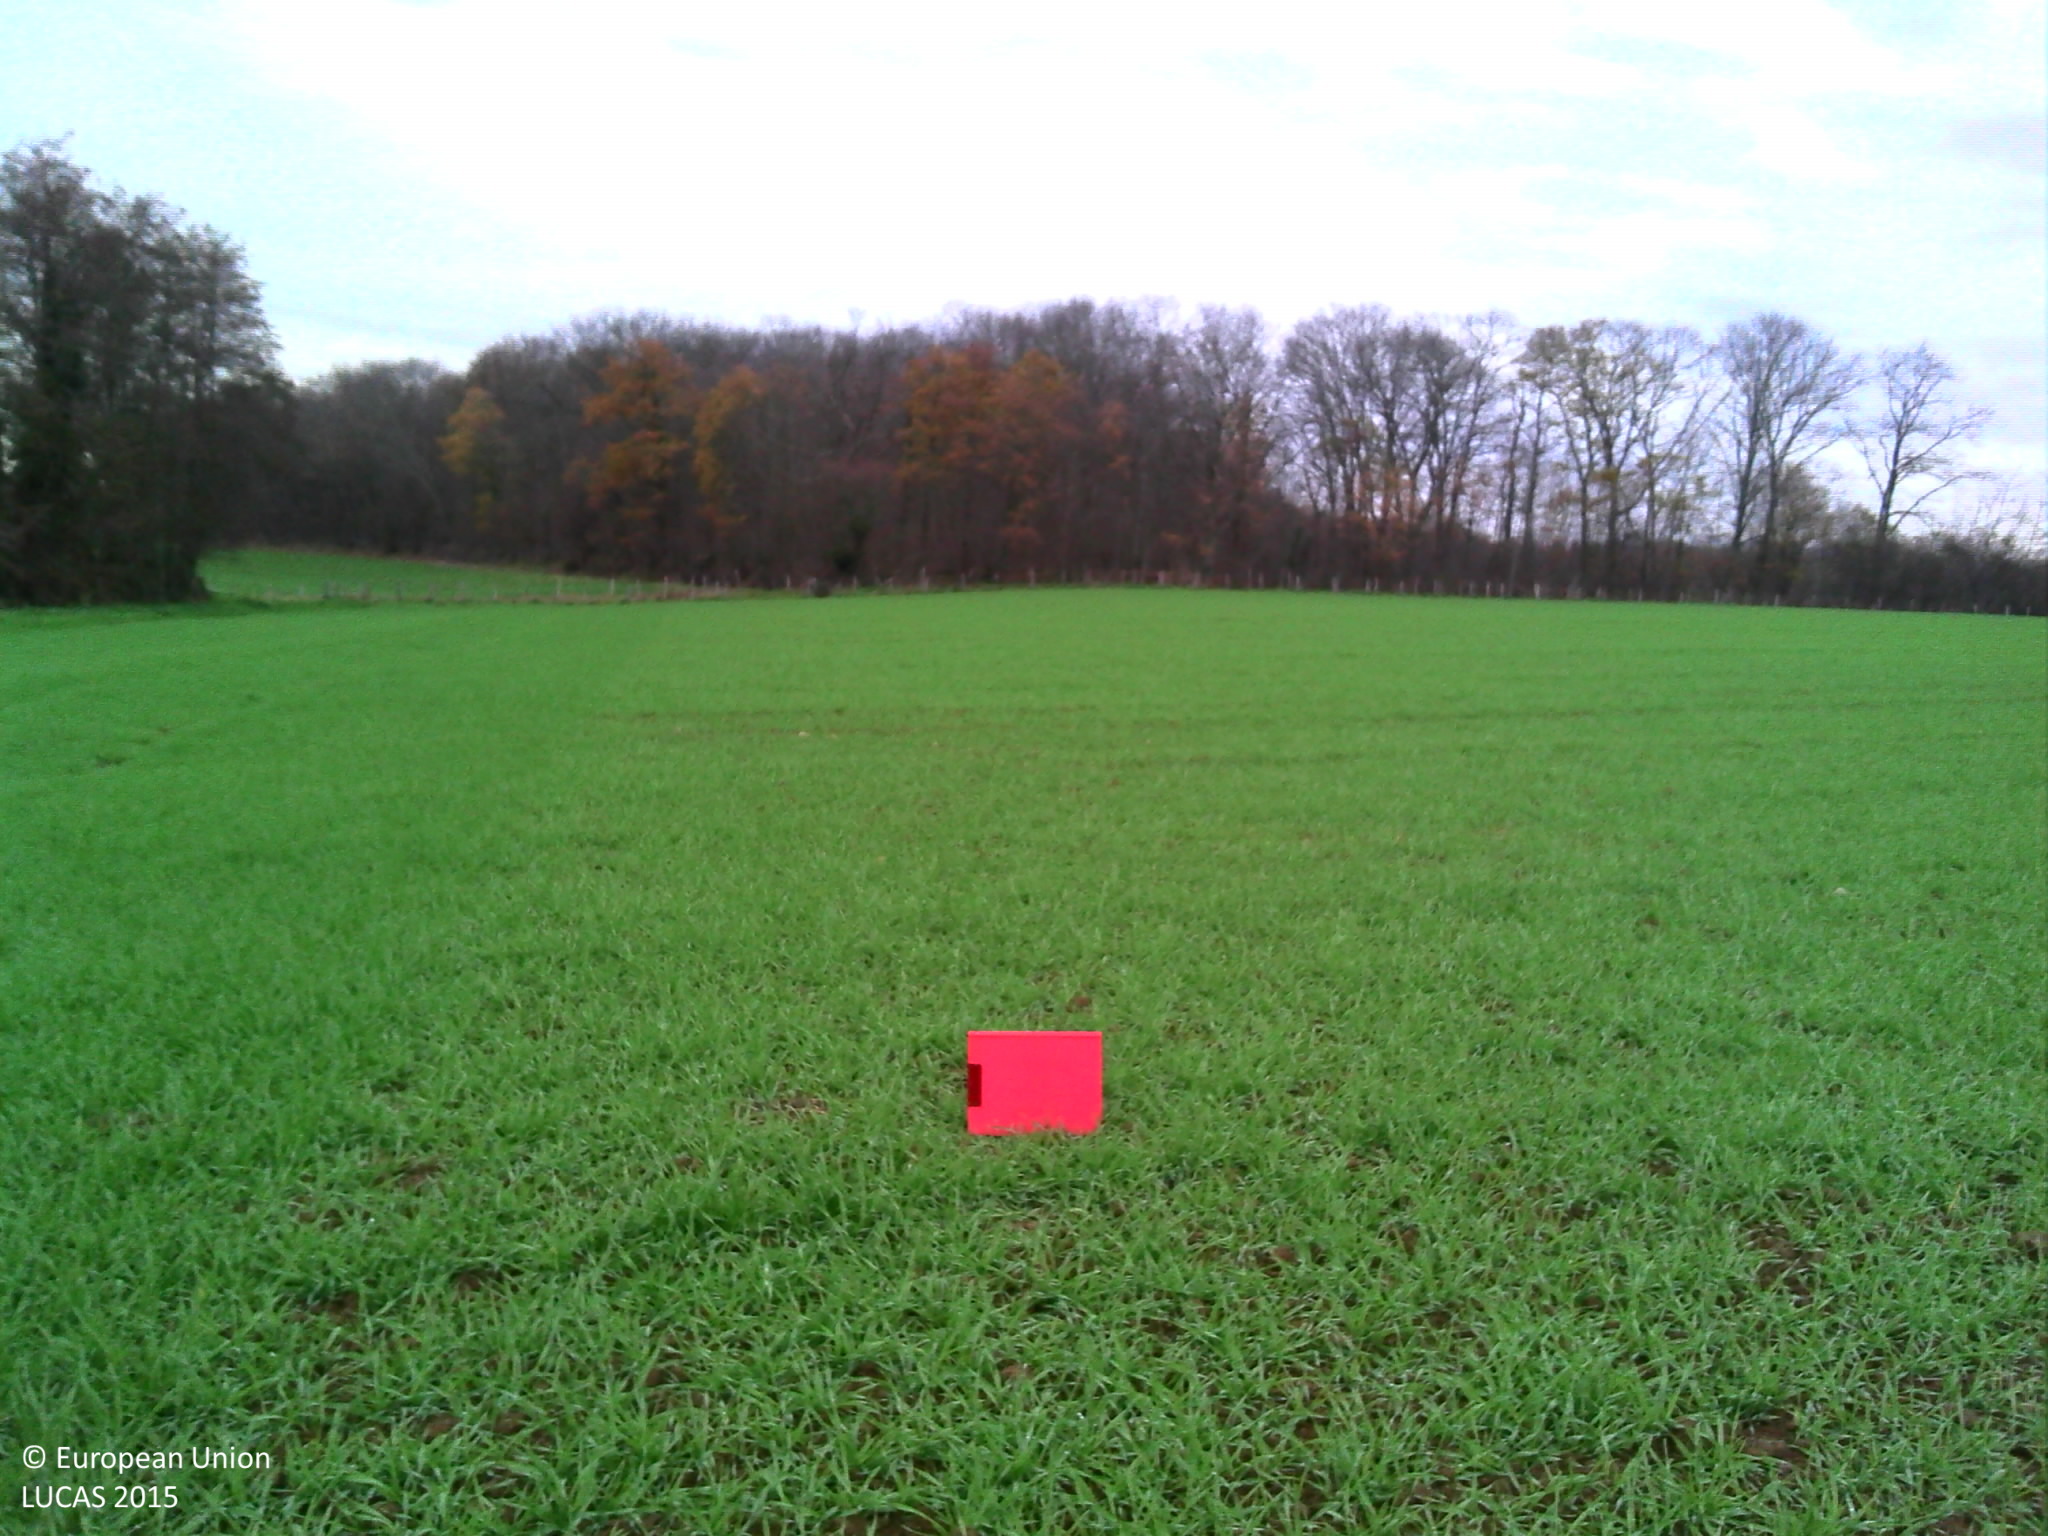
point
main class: Cropland
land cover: Common wheat
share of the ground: > 75 %
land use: Agriculture (excluding fallow land and kitchen gardens)
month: December
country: FR
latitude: 46.1329
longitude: 5.1493
